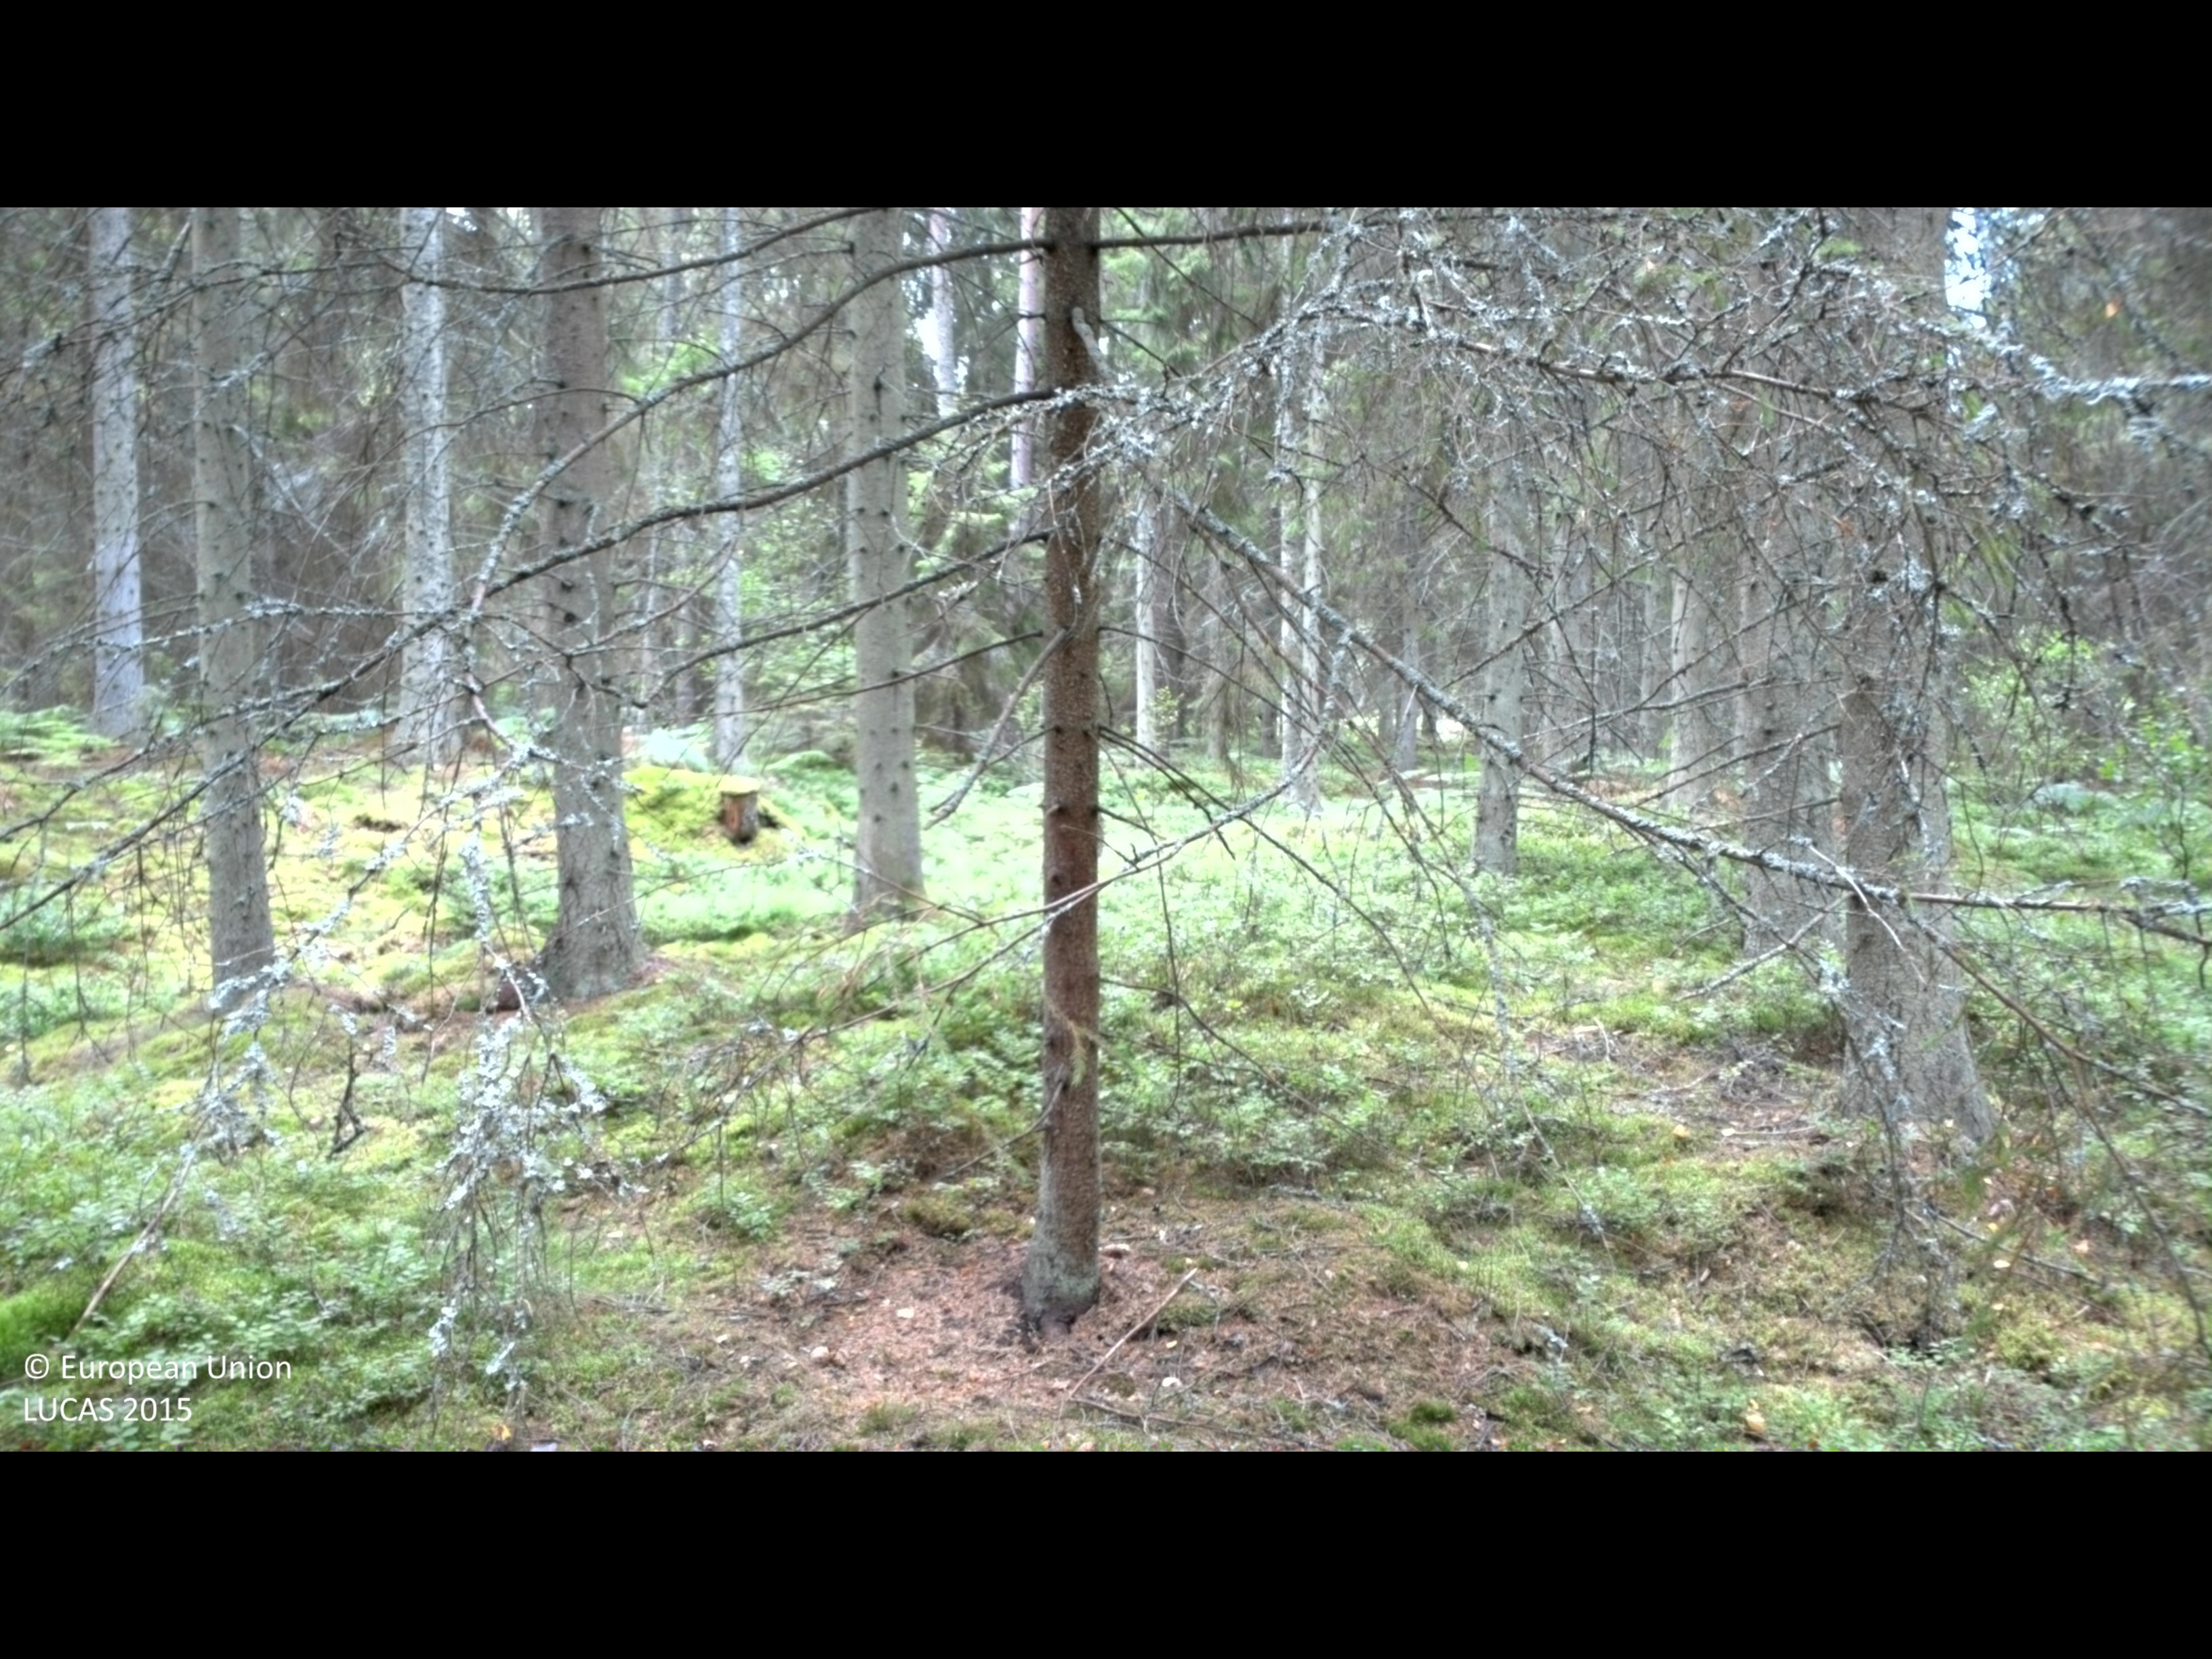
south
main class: Woodland
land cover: Spruce dominated coniferous woodland
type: boreal forest
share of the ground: > 75 %
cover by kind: coniferous forest trees 75 %, shrubs 15 %, herbaceous plants 5 %, lichens and mosses 5 %
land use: Forestry
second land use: Amenities, museums, leisure
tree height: > 5 m
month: July
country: SE
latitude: 57.2937
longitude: 17.0541
